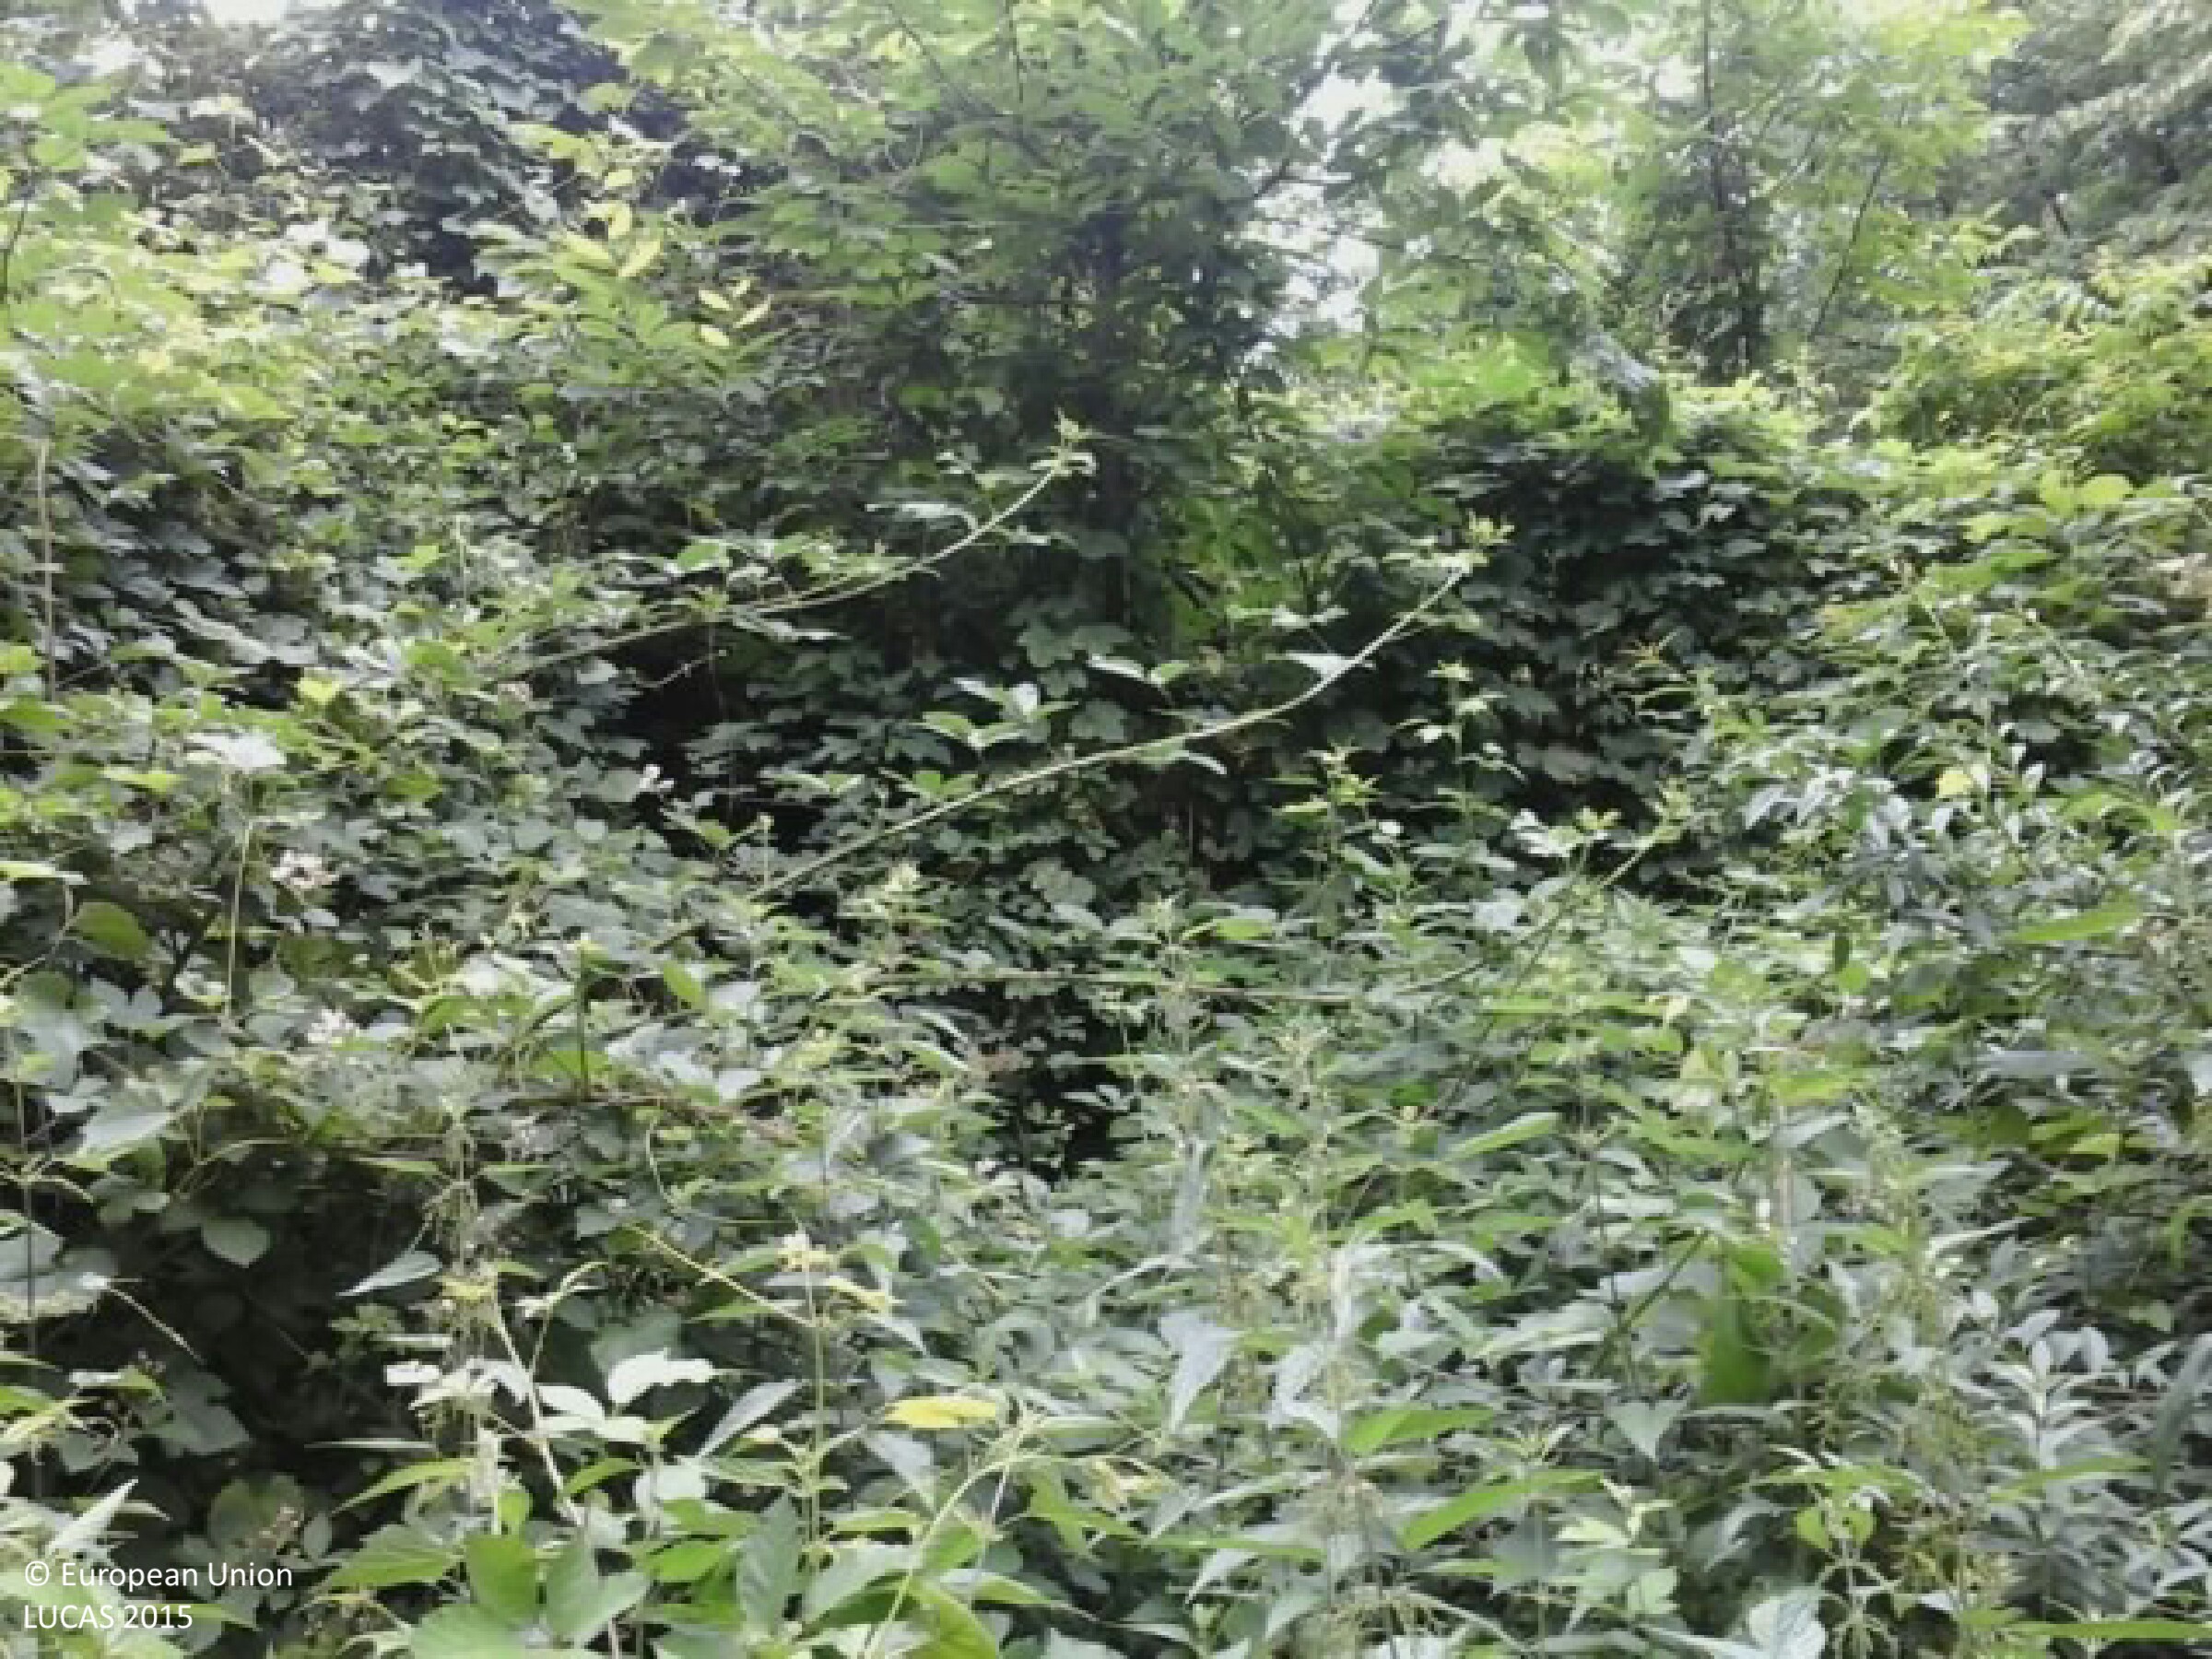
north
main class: Woodland
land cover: Broadleaved woodland
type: mesophytic deciduous forest
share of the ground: > 75 %
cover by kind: broadleaved forest trees 75 %, shrubs 15 %, herbaceous plants 10 %
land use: Forestry
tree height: > 5 m
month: June
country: HU
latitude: 46.2809
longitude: 17.8317
